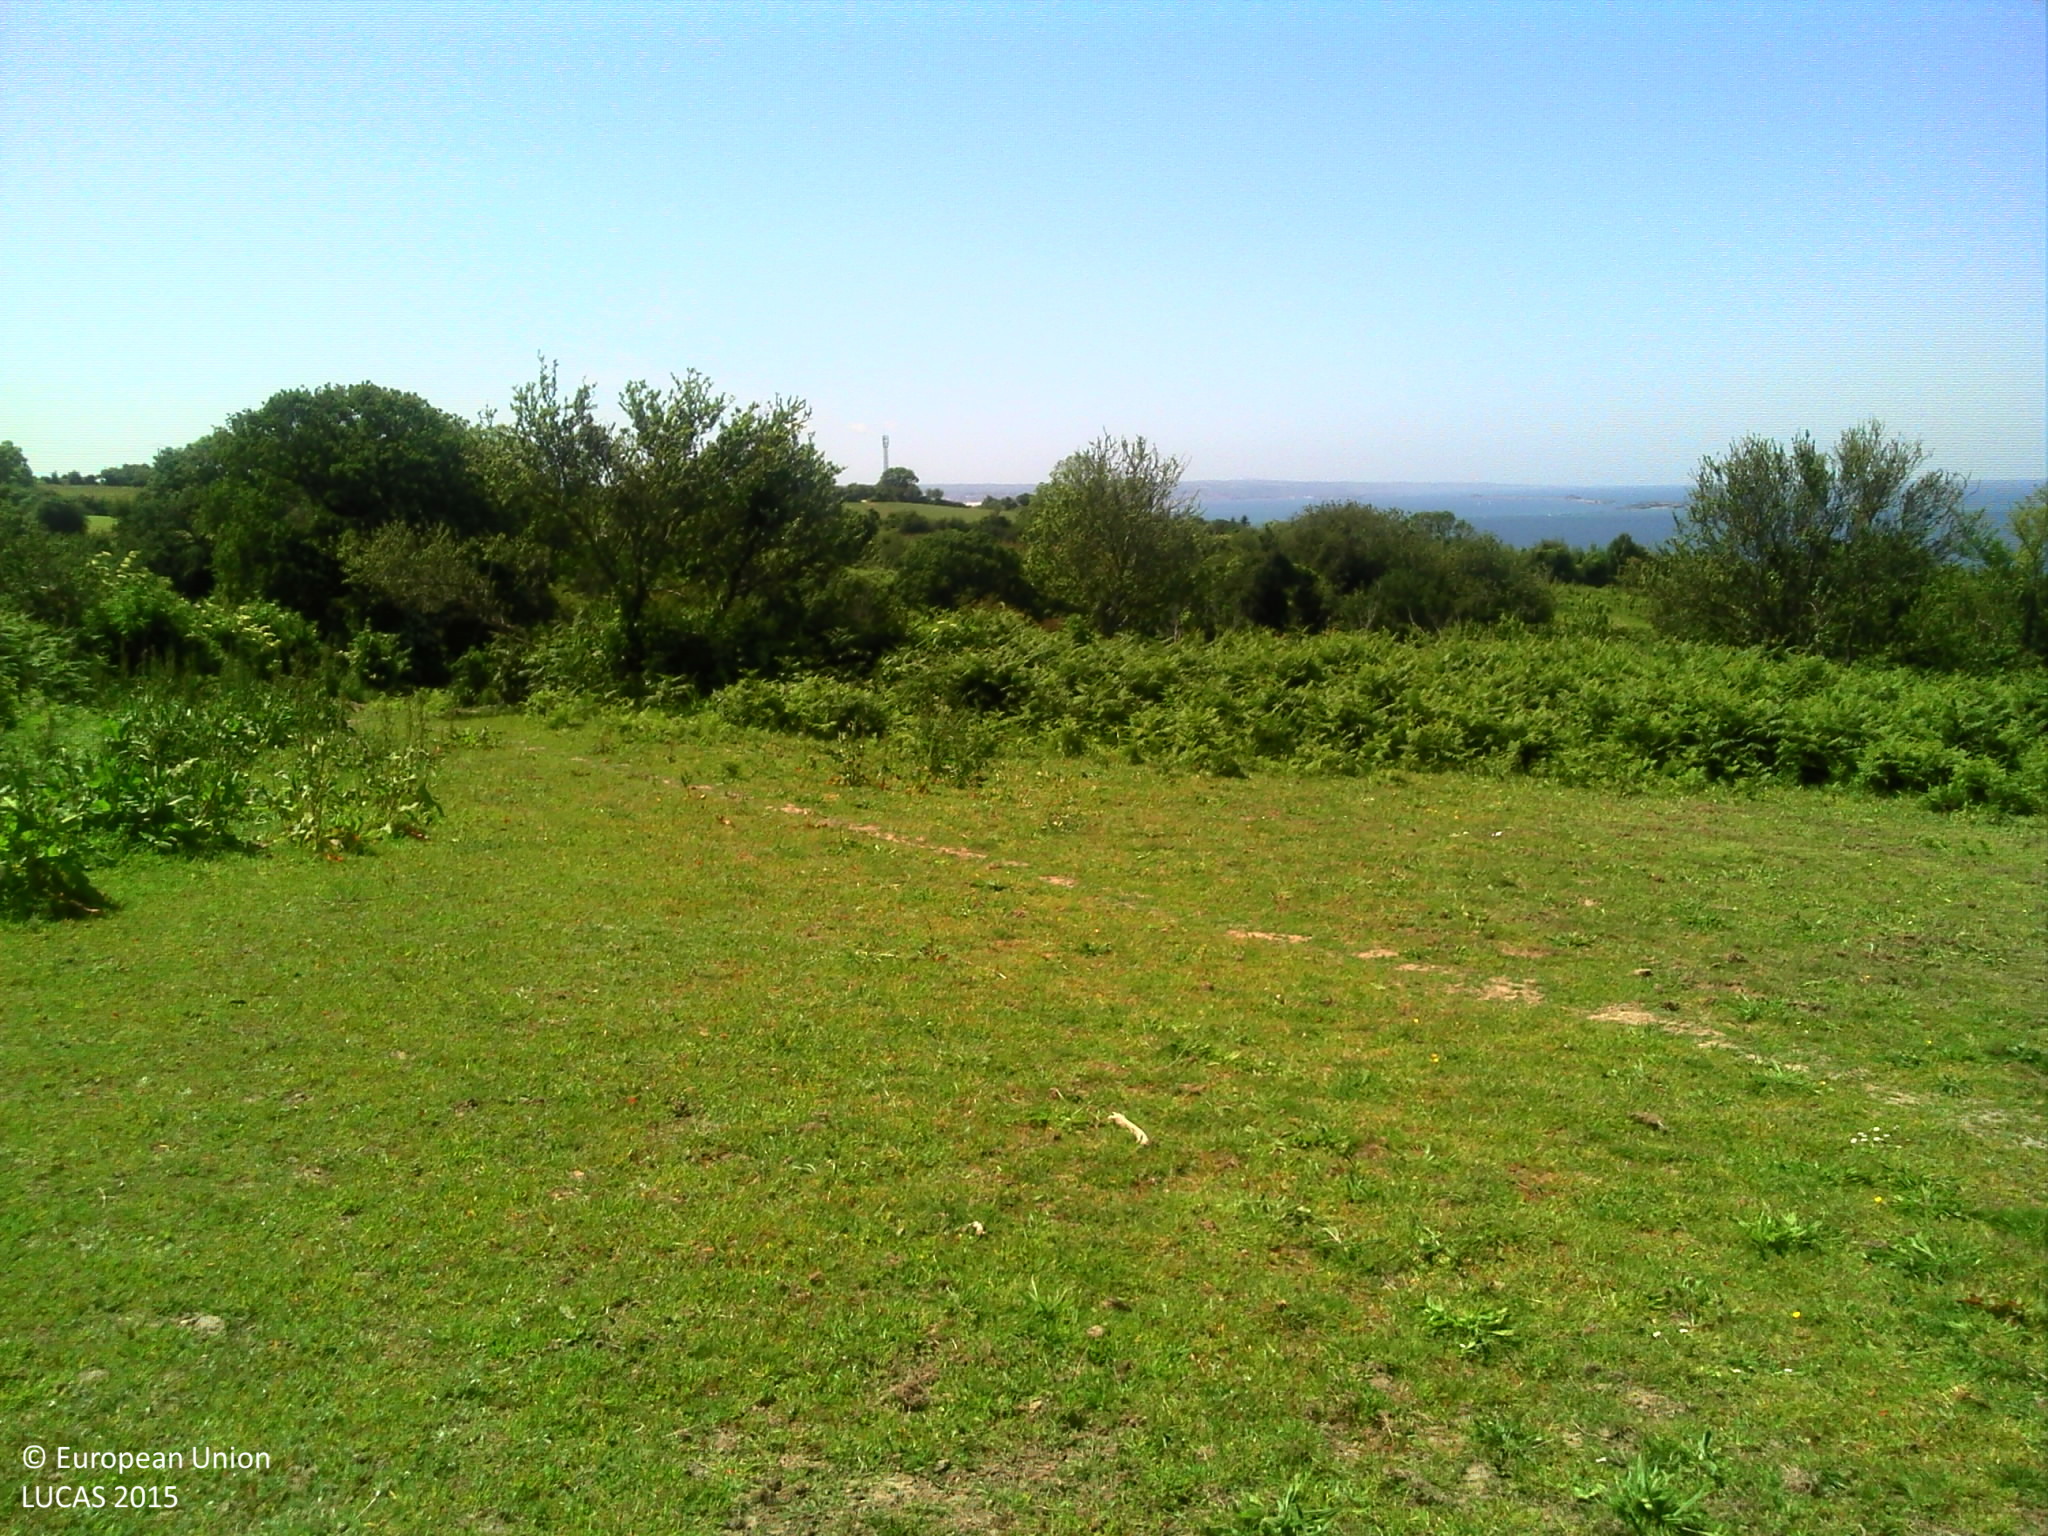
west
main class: Grassland
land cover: Grassland without tree/shrub cover
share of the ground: > 75 %
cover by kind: herbaceous plants 100 %
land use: Agriculture (excluding fallow land and kitchen gardens)
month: June
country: FR
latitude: 49.6541
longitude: -1.5051
